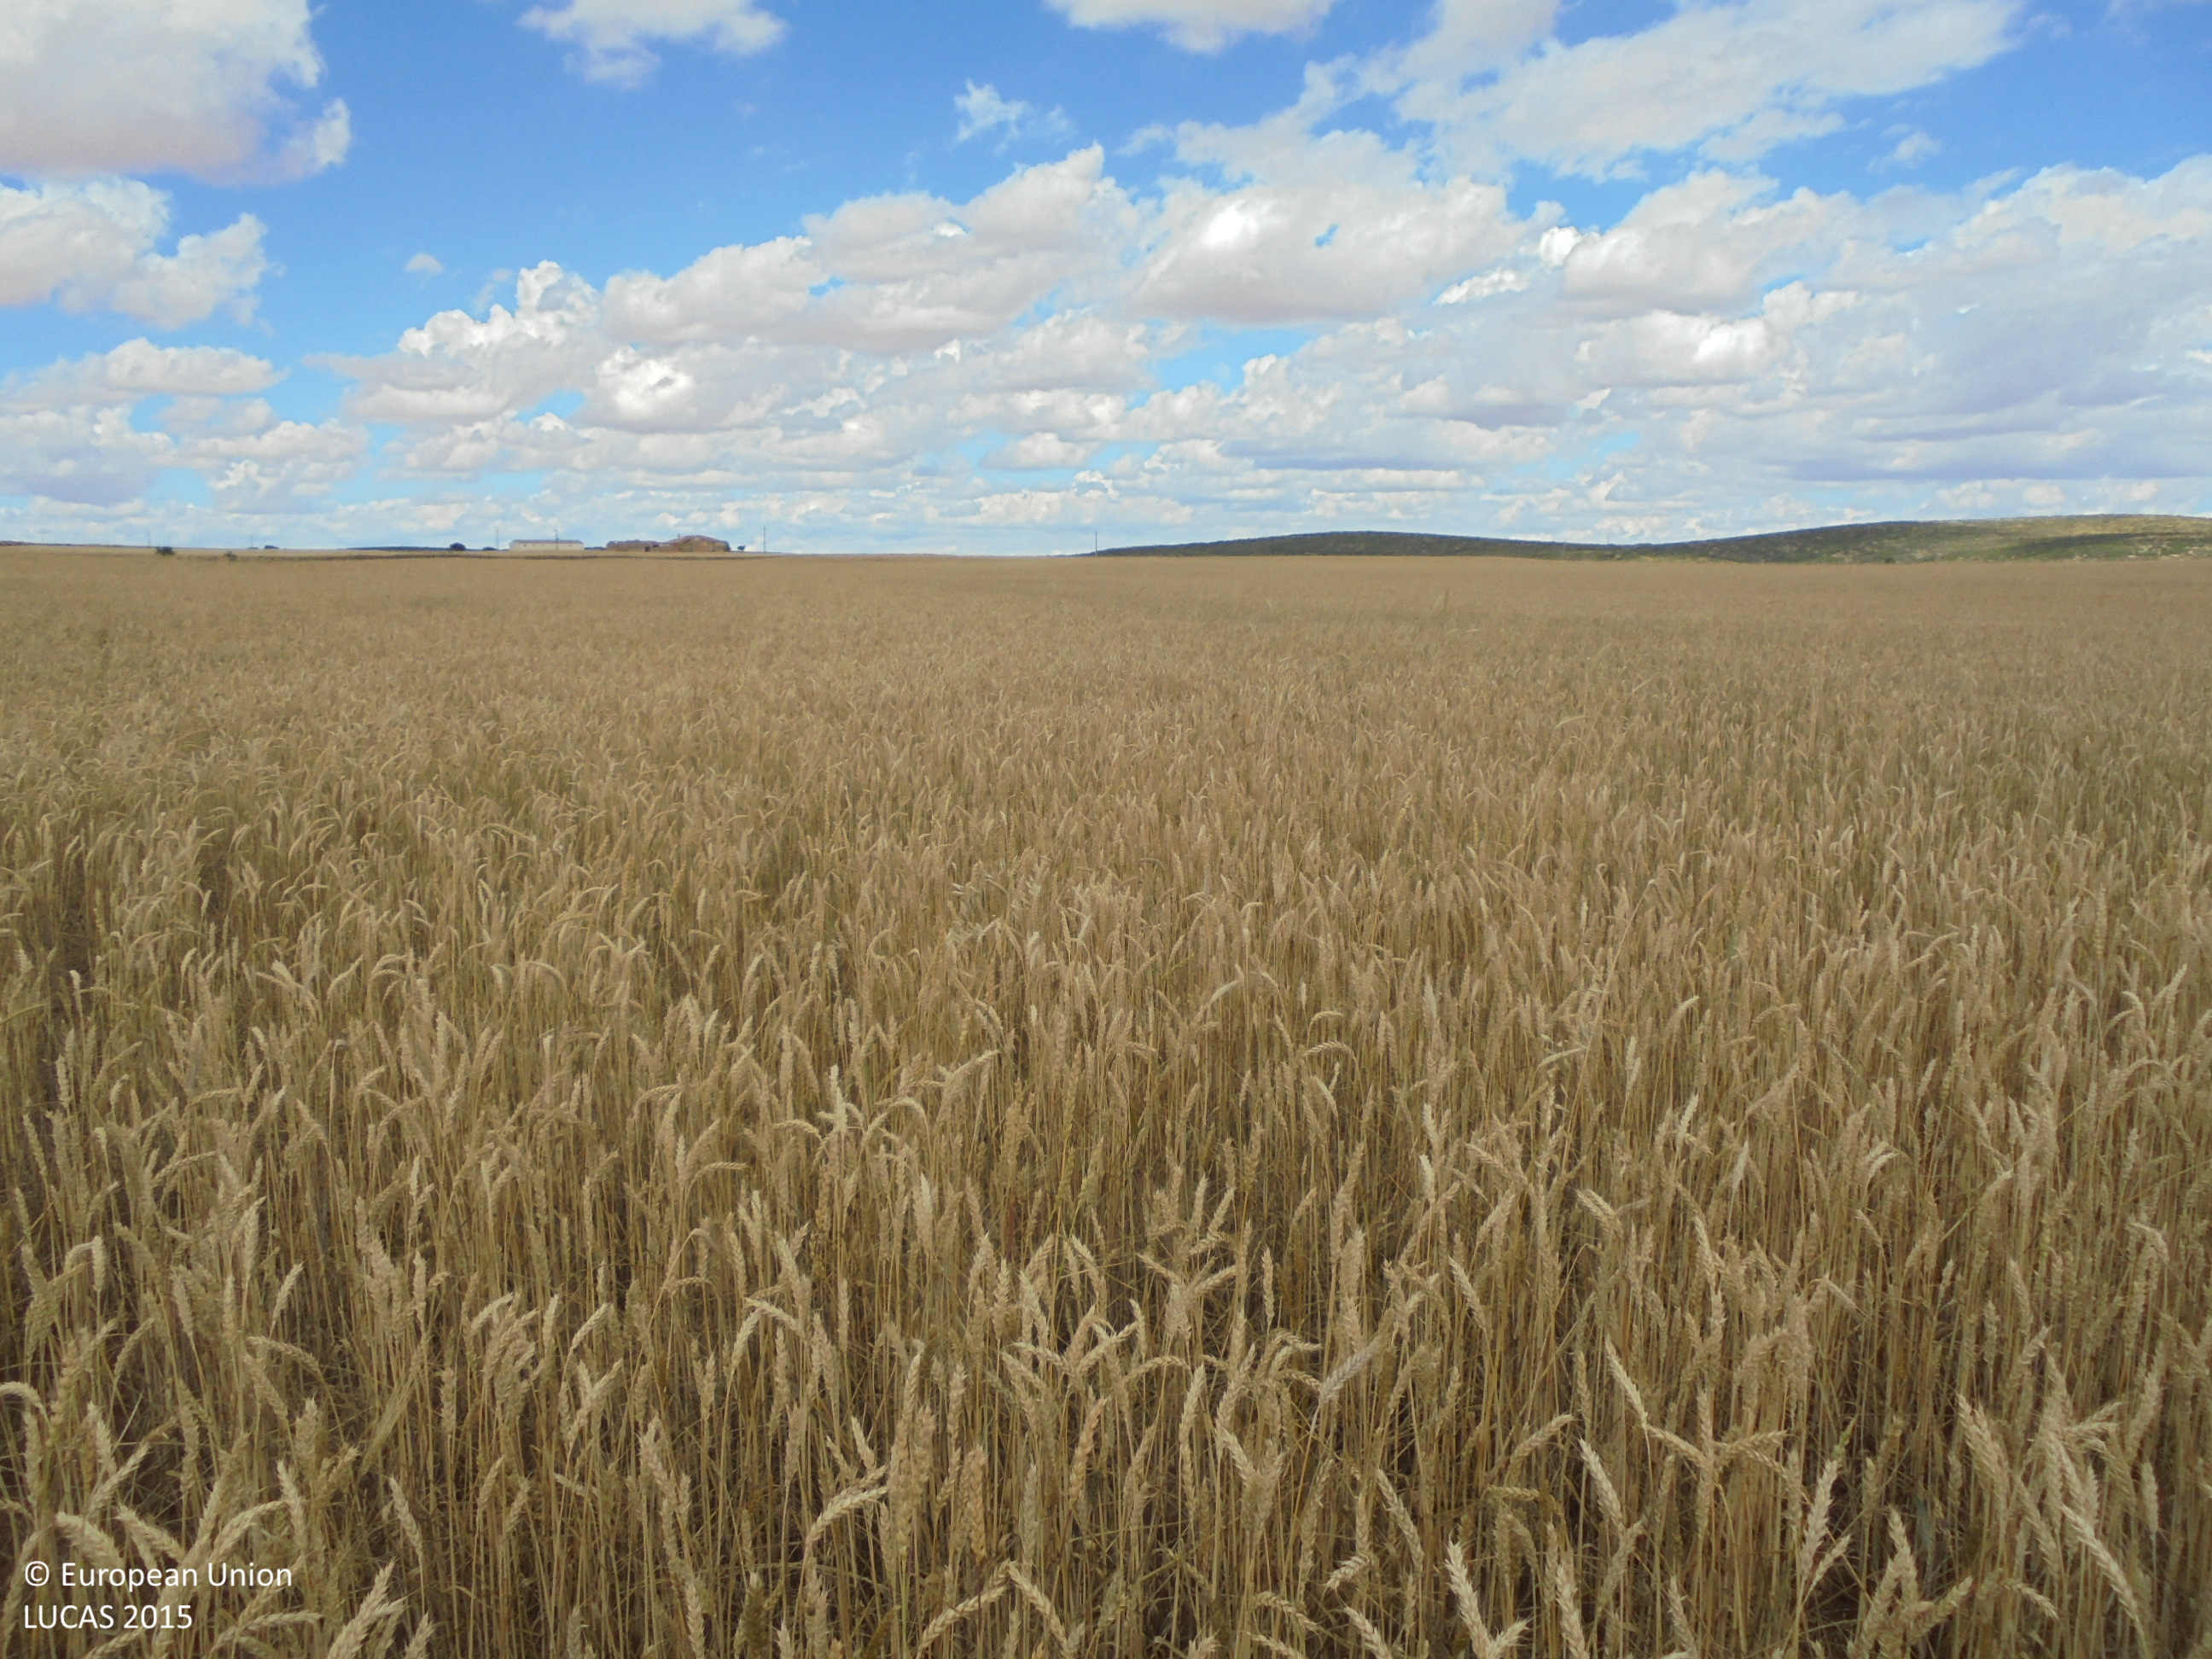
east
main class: Cropland
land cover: Durum wheat
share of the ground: > 75 %
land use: Agriculture (excluding fallow land and kitchen gardens)
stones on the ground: < 10 %
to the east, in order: Durum wheat
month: June
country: ES
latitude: 38.7578
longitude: -1.4217
